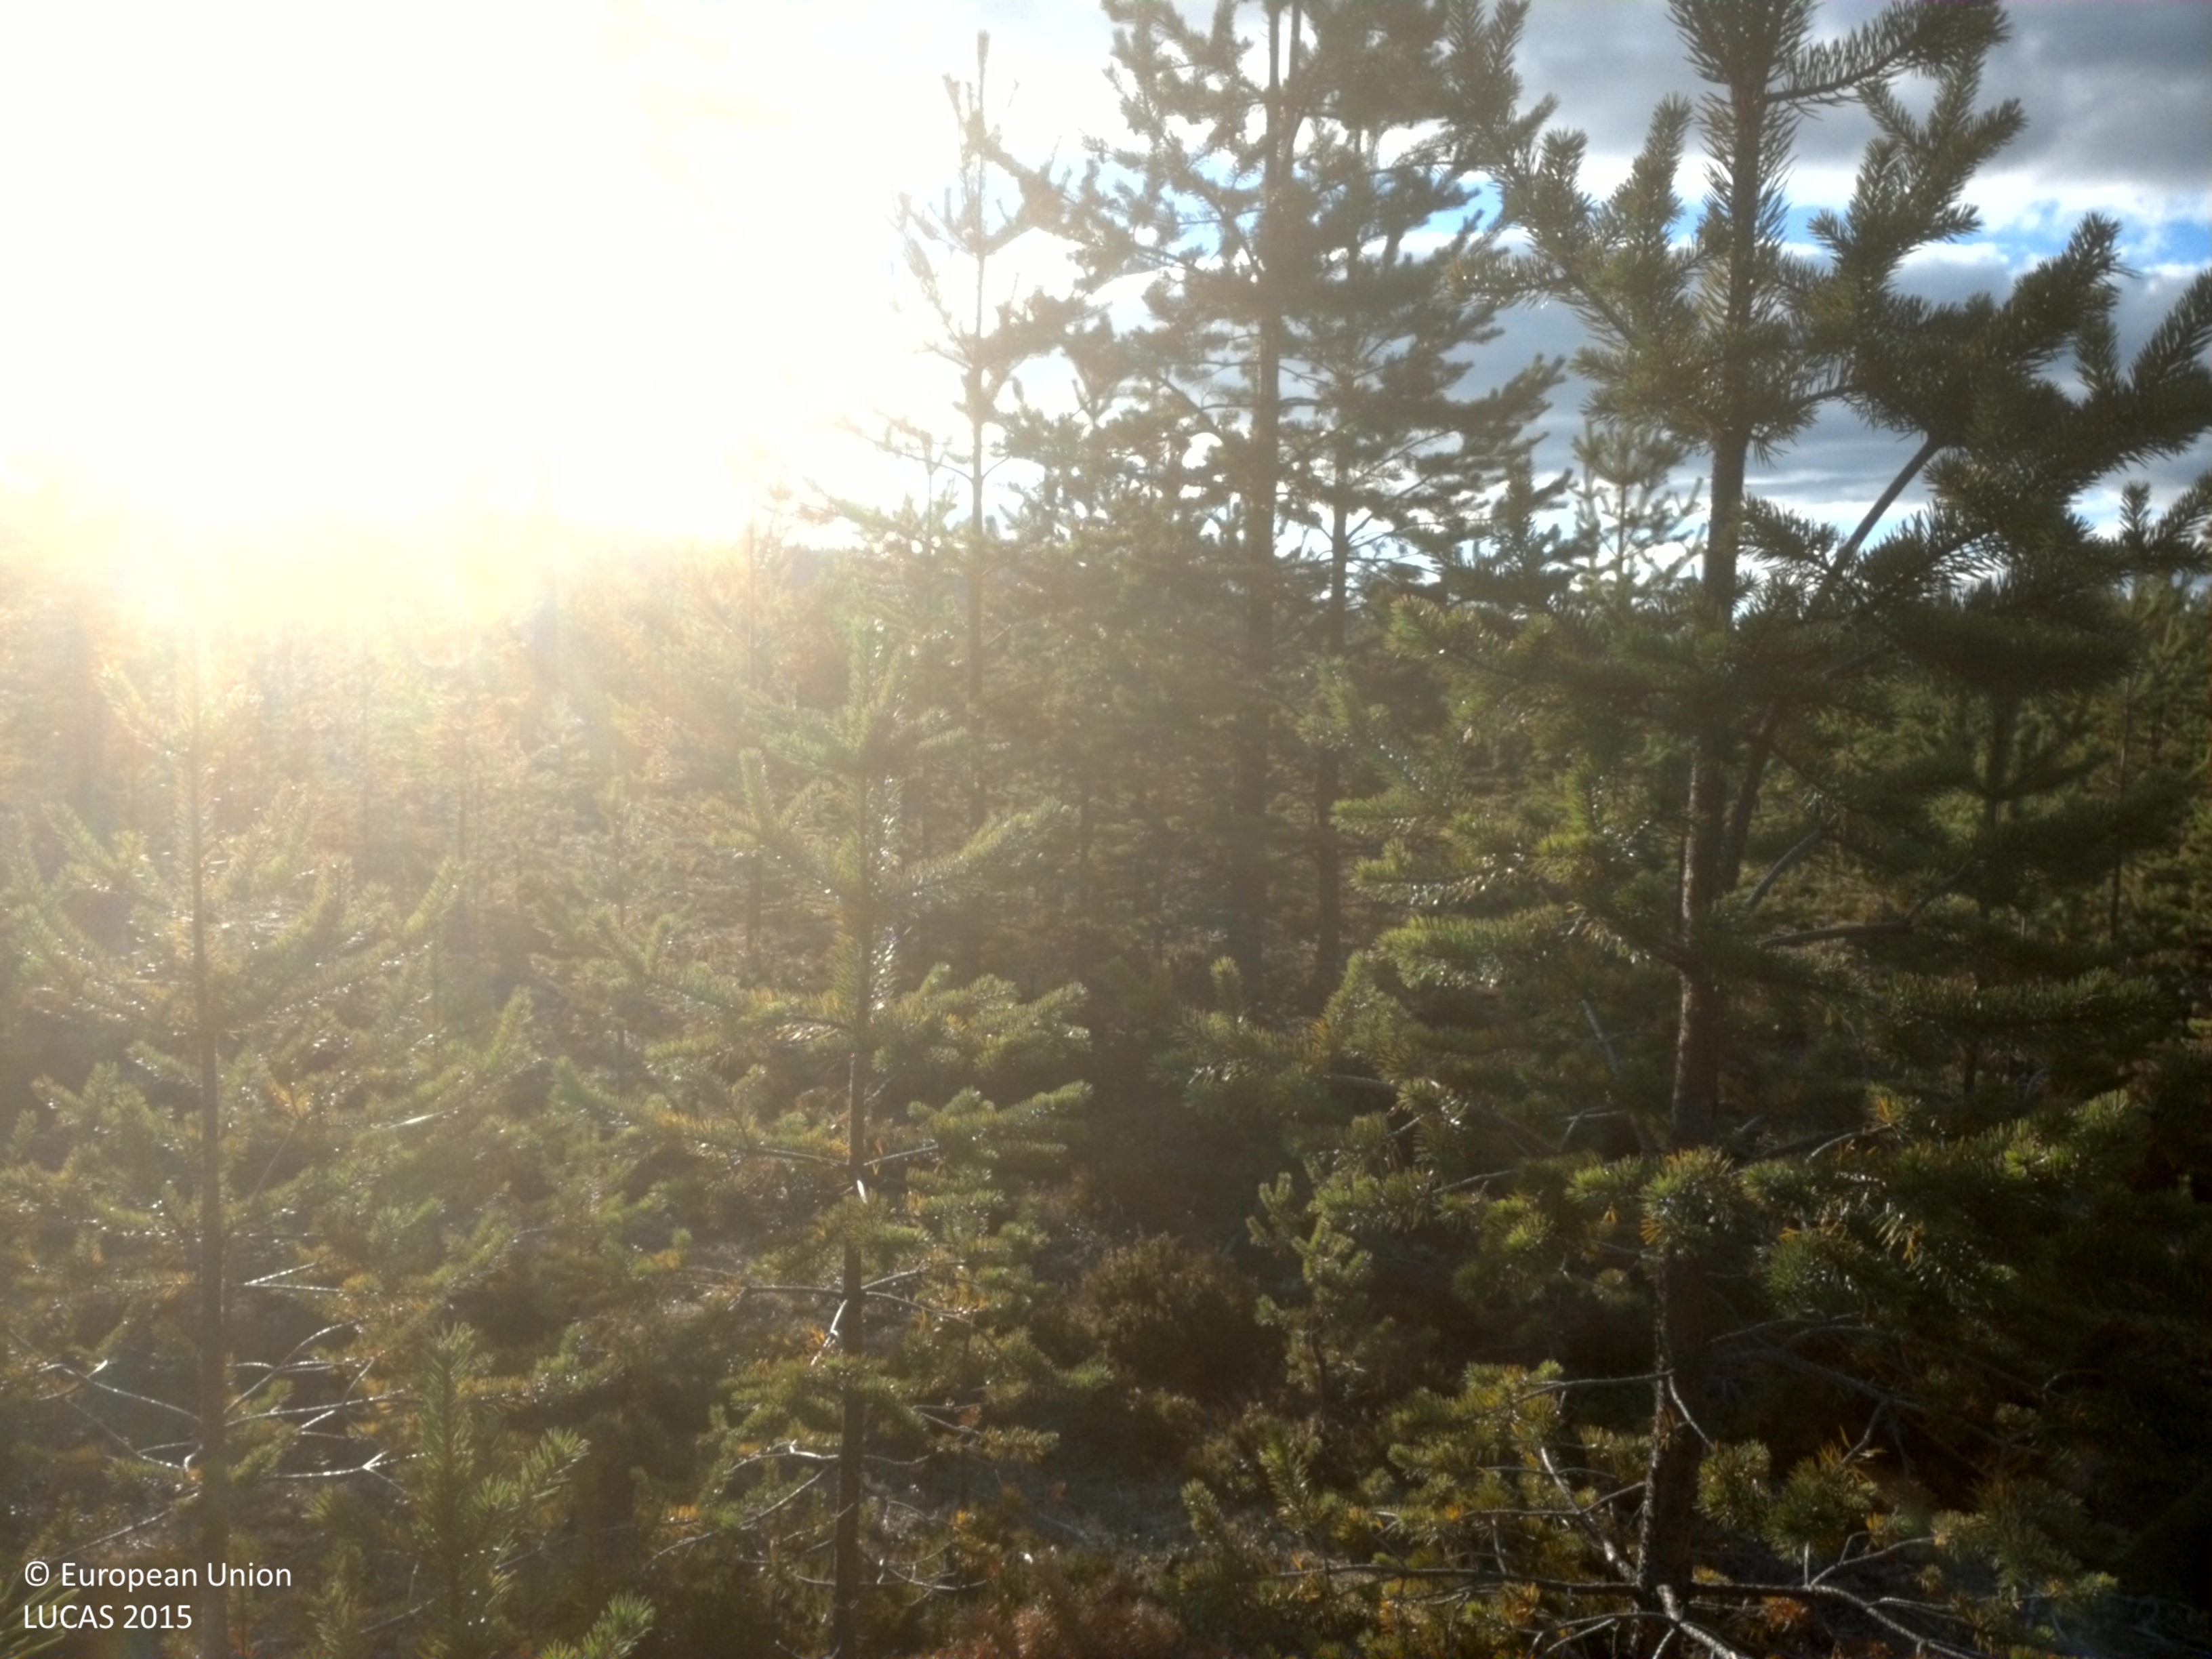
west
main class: Woodland
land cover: Pine dominated coniferous woodland
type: boreal forest
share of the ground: 50 - 75 %
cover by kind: coniferous forest trees 65 %, lichens and mosses 25 %, shrubs 10 %
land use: Forestry
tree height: < 5 m
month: September
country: SE
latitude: 64.4355
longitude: 18.9633
